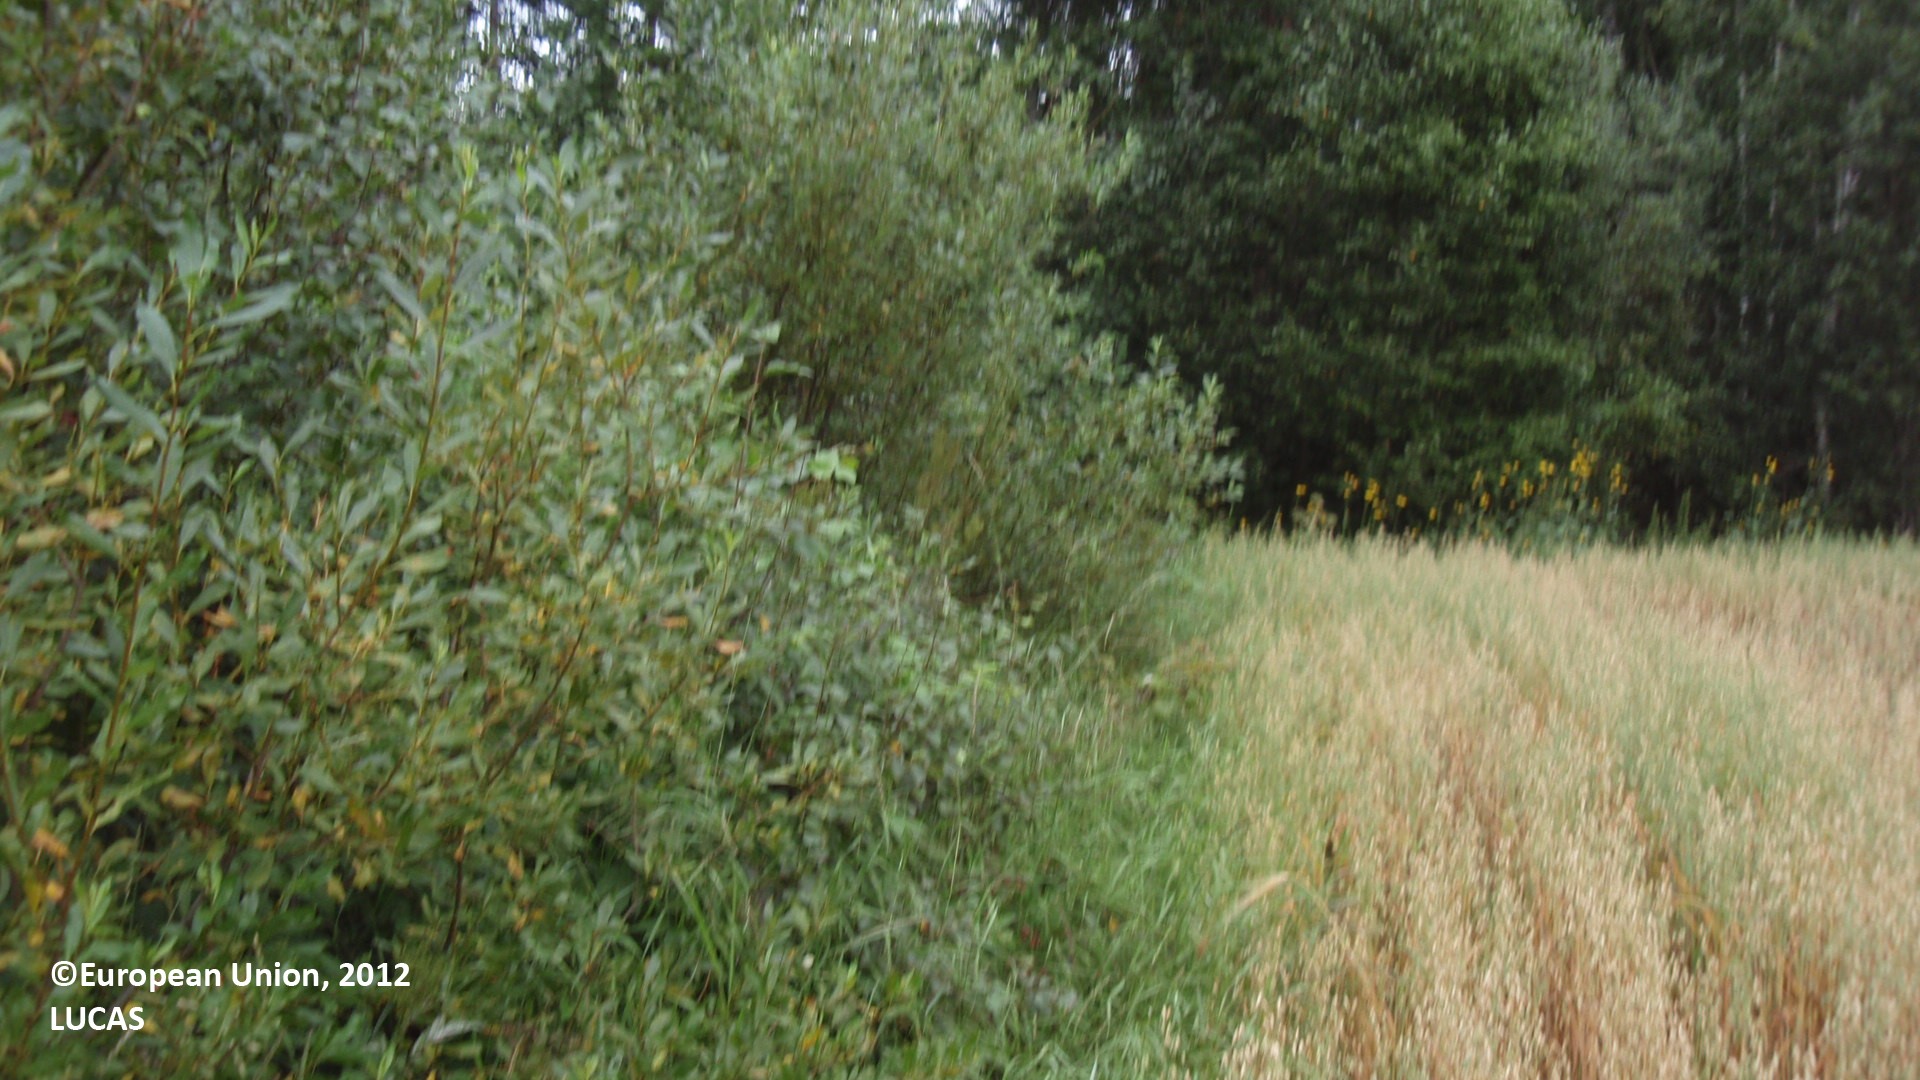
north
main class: Cropland
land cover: Oats
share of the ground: > 75 %
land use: Agriculture (excluding fallow land and kitchen gardens)
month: August
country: FI
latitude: 60.9938
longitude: 27.5432
